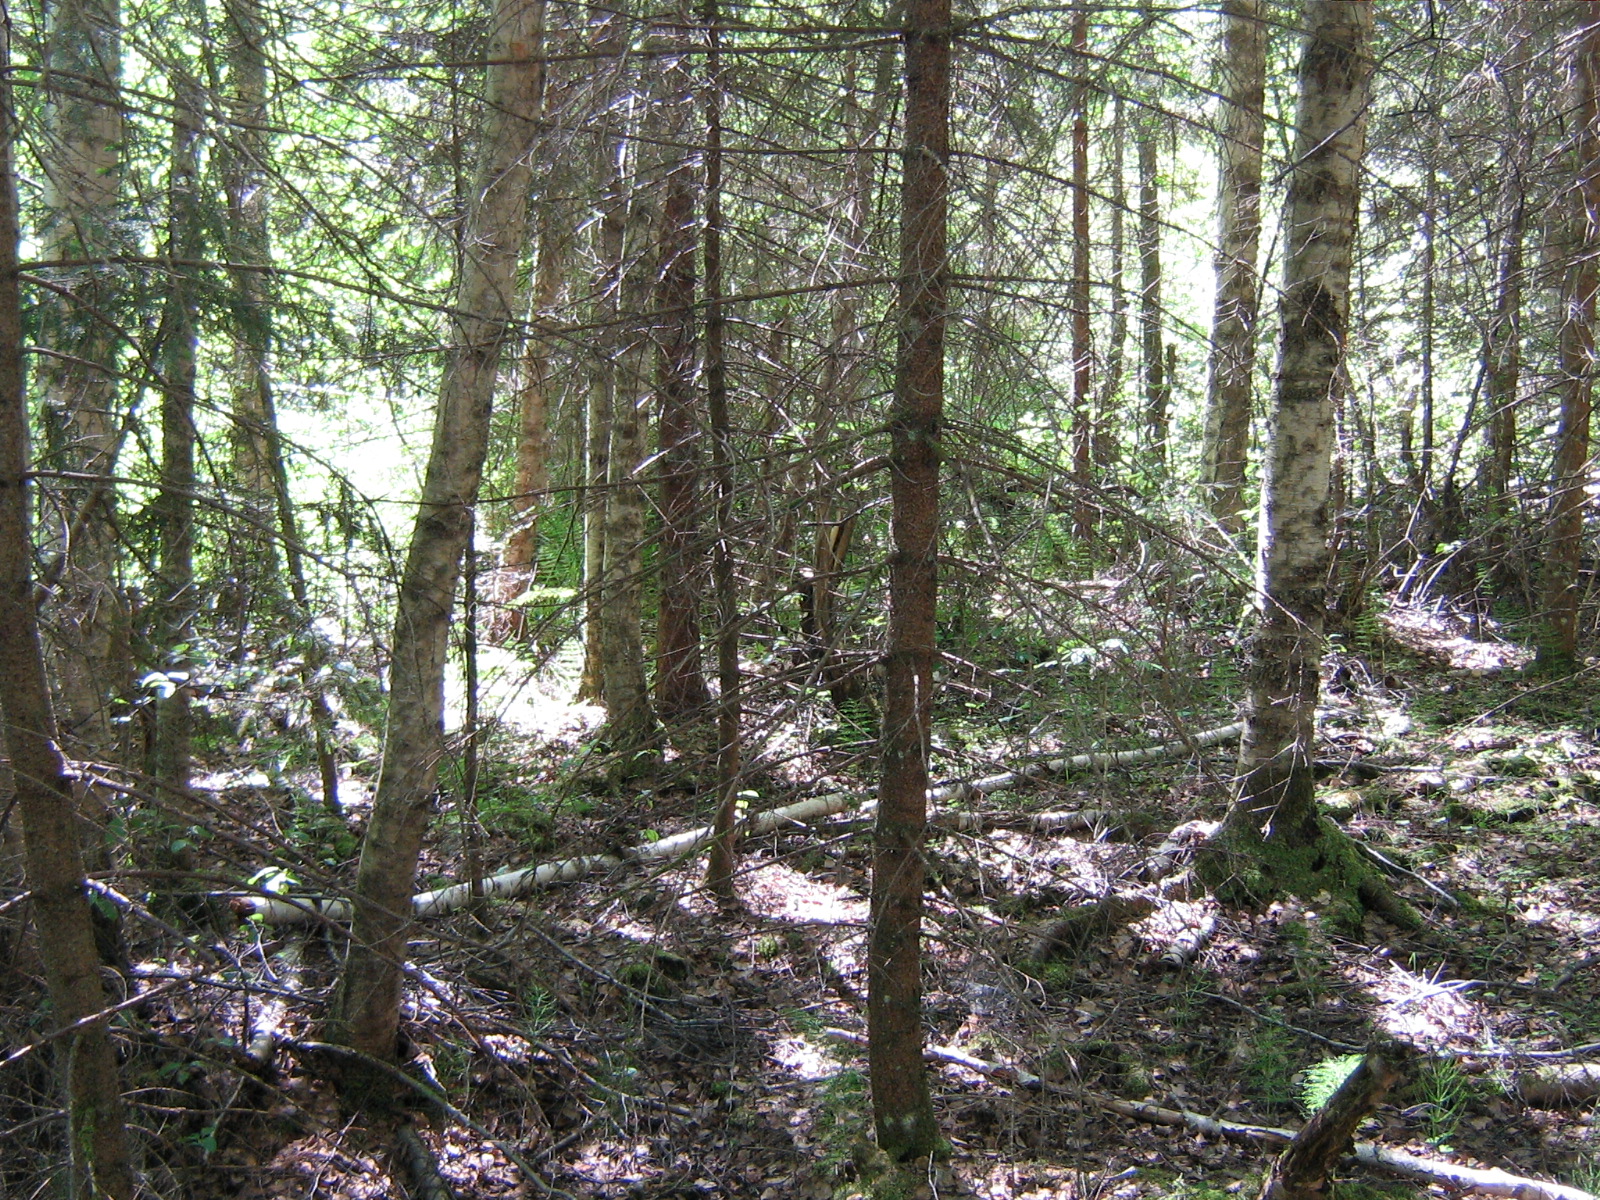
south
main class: Woodland
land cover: Other mixed woodland
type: hemiboreal forest and nemoral coniferous forest and mixed broadleaved-coniferous forest
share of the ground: > 75 %
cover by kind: broadleaved forest trees 65 %, coniferous forest trees 35 %
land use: Forestry
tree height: > 5 m
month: June
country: LV
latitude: 57.0856
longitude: 25.8517
